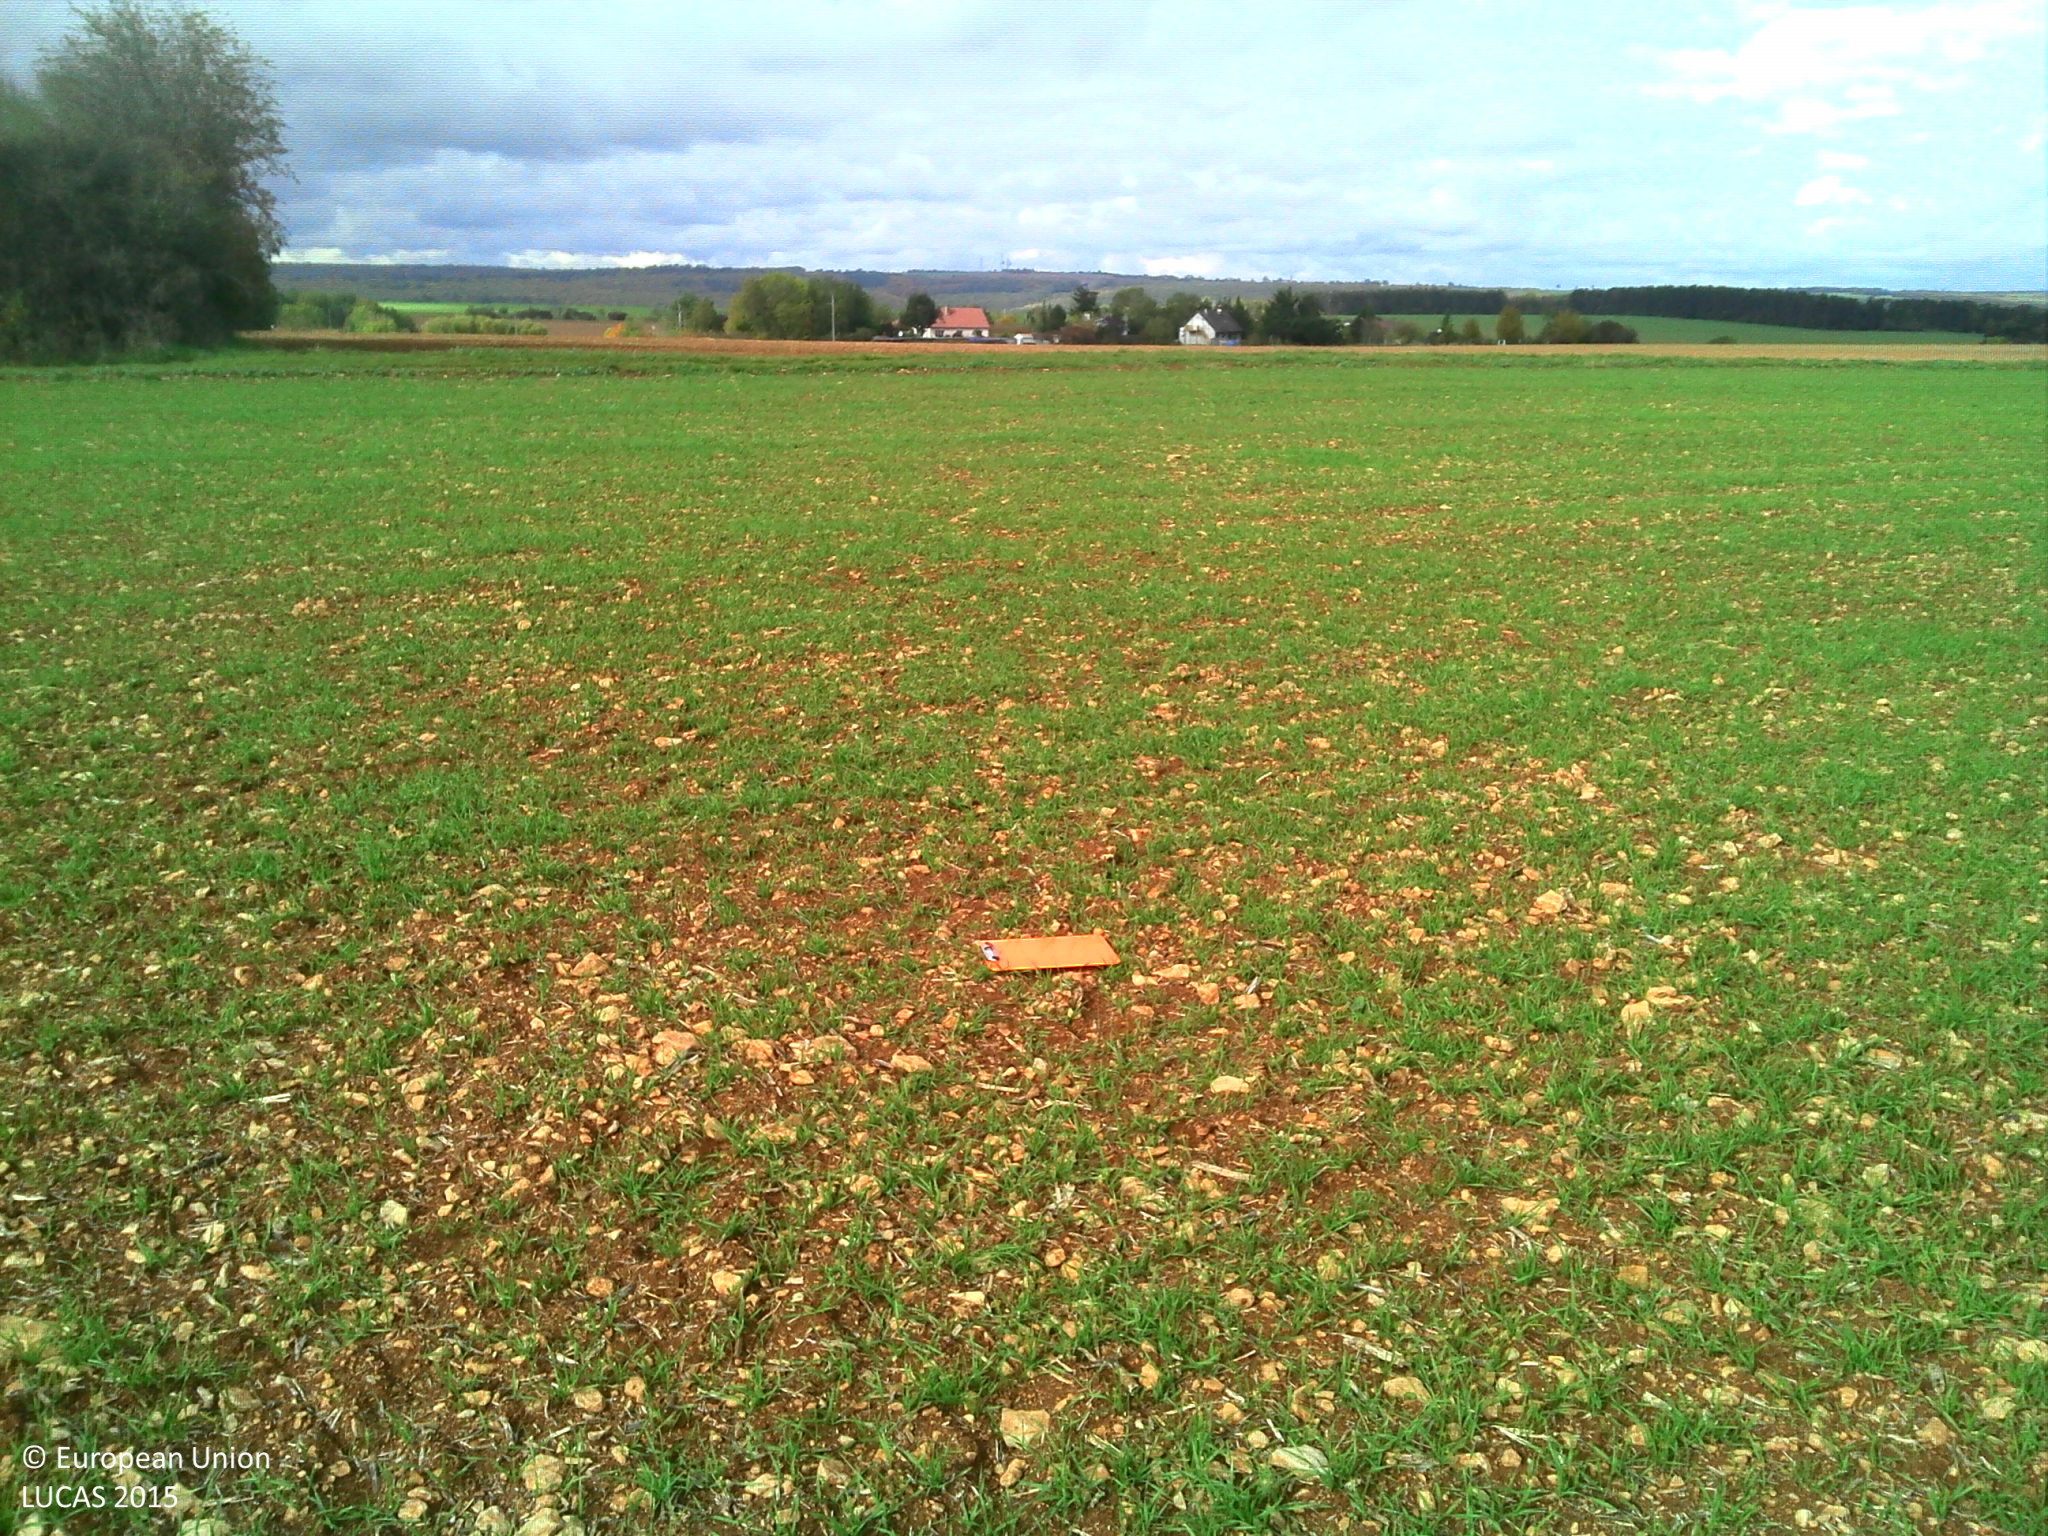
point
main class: Cropland
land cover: Common wheat
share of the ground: 25 - 50 %
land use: Agriculture (excluding fallow land and kitchen gardens)
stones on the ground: 25 - 50 %
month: October
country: FR
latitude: 47.4047
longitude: 4.9514
